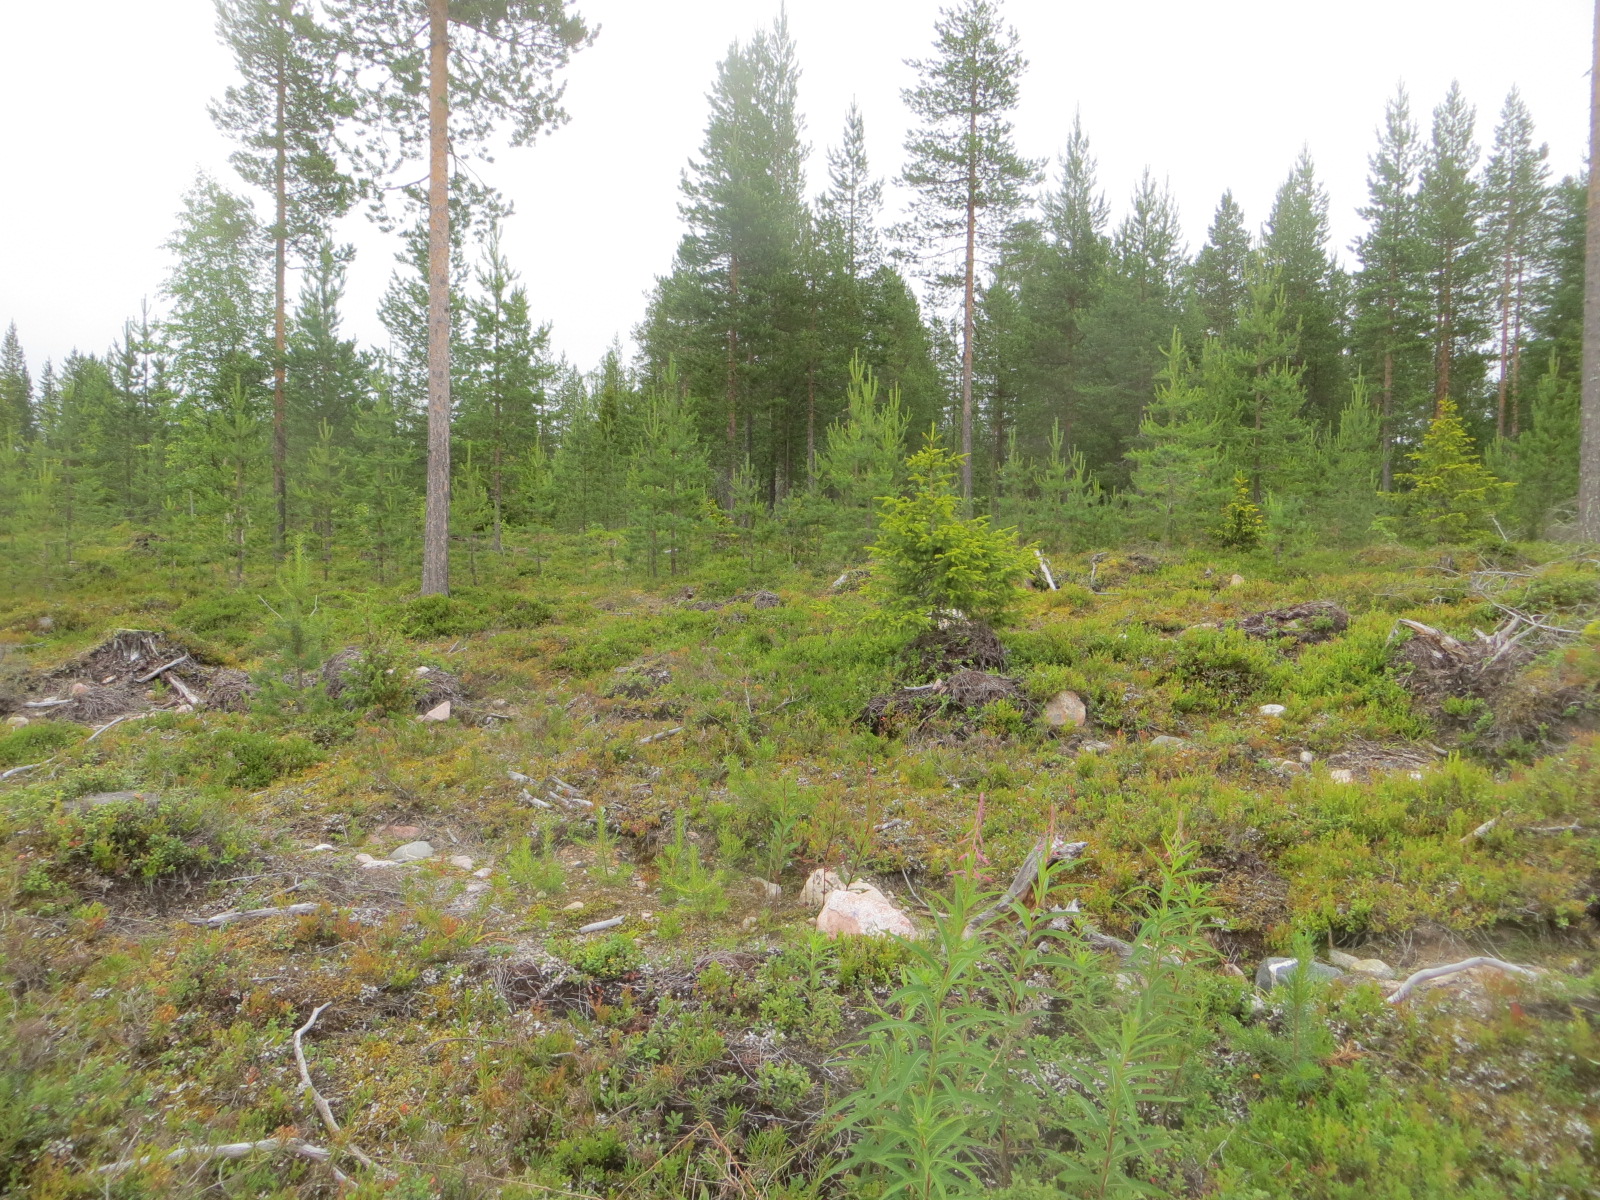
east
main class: Woodland
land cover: Pine dominated coniferous woodland
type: boreal forest
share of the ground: 25 - 50 %
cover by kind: shrubs 70 %, coniferous forest trees 25 %, broadleaved forest trees 5 %
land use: Forestry
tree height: < 5 m
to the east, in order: Pine dominated coniferous woodland; Lichens and moss; Ditches and canals; Shrubland without tree cover; Paved roads, cycling and walking lanes; Shrubland with sparse tree cover; Ditches and canals; Broadleaved woodland; Pine dominated mixed woodland
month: July
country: FI
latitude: 66.4296
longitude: 24.4093
